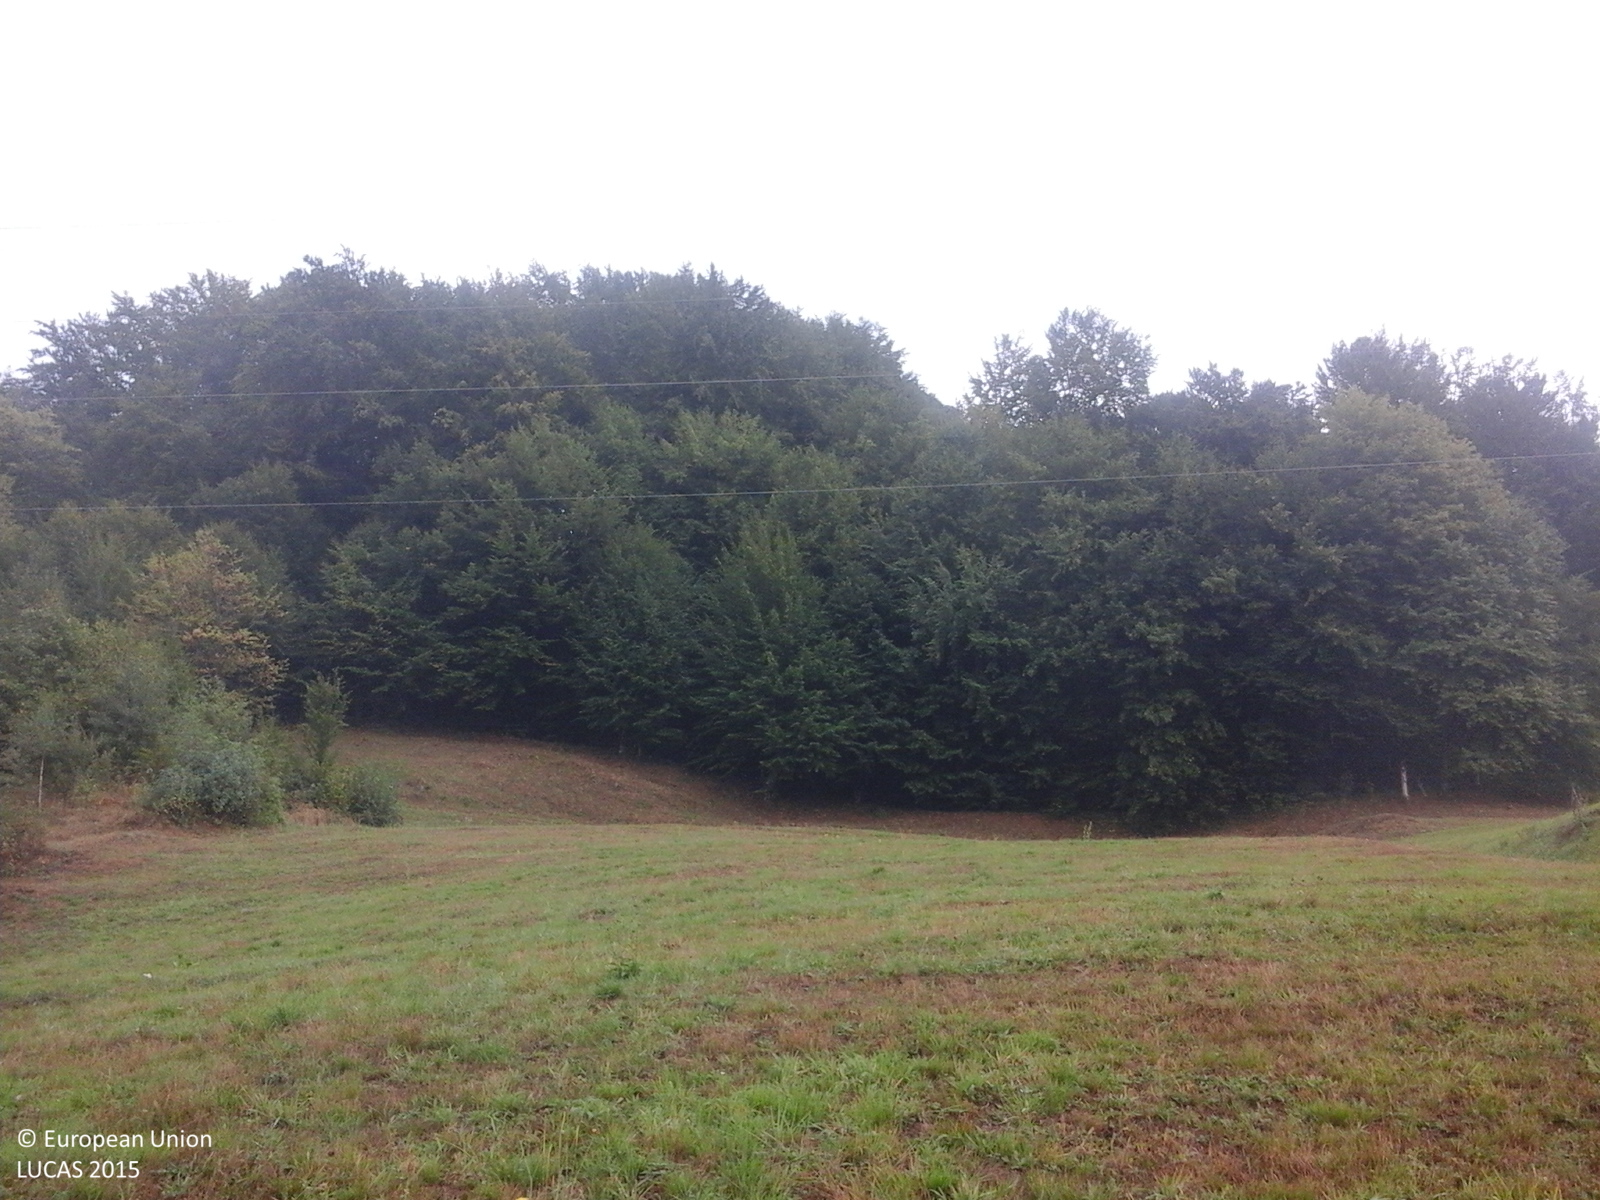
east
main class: Grassland
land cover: Grassland without tree/shrub cover
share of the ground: > 75 %
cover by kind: herbaceous plants 100 %
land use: Agriculture (excluding fallow land and kitchen gardens)
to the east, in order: Grassland without tree/shrub cover; Electric lines; Grassland without tree/shrub cover; Broadleaved woodland
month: September
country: RO
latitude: 47.6008
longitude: 23.9827
